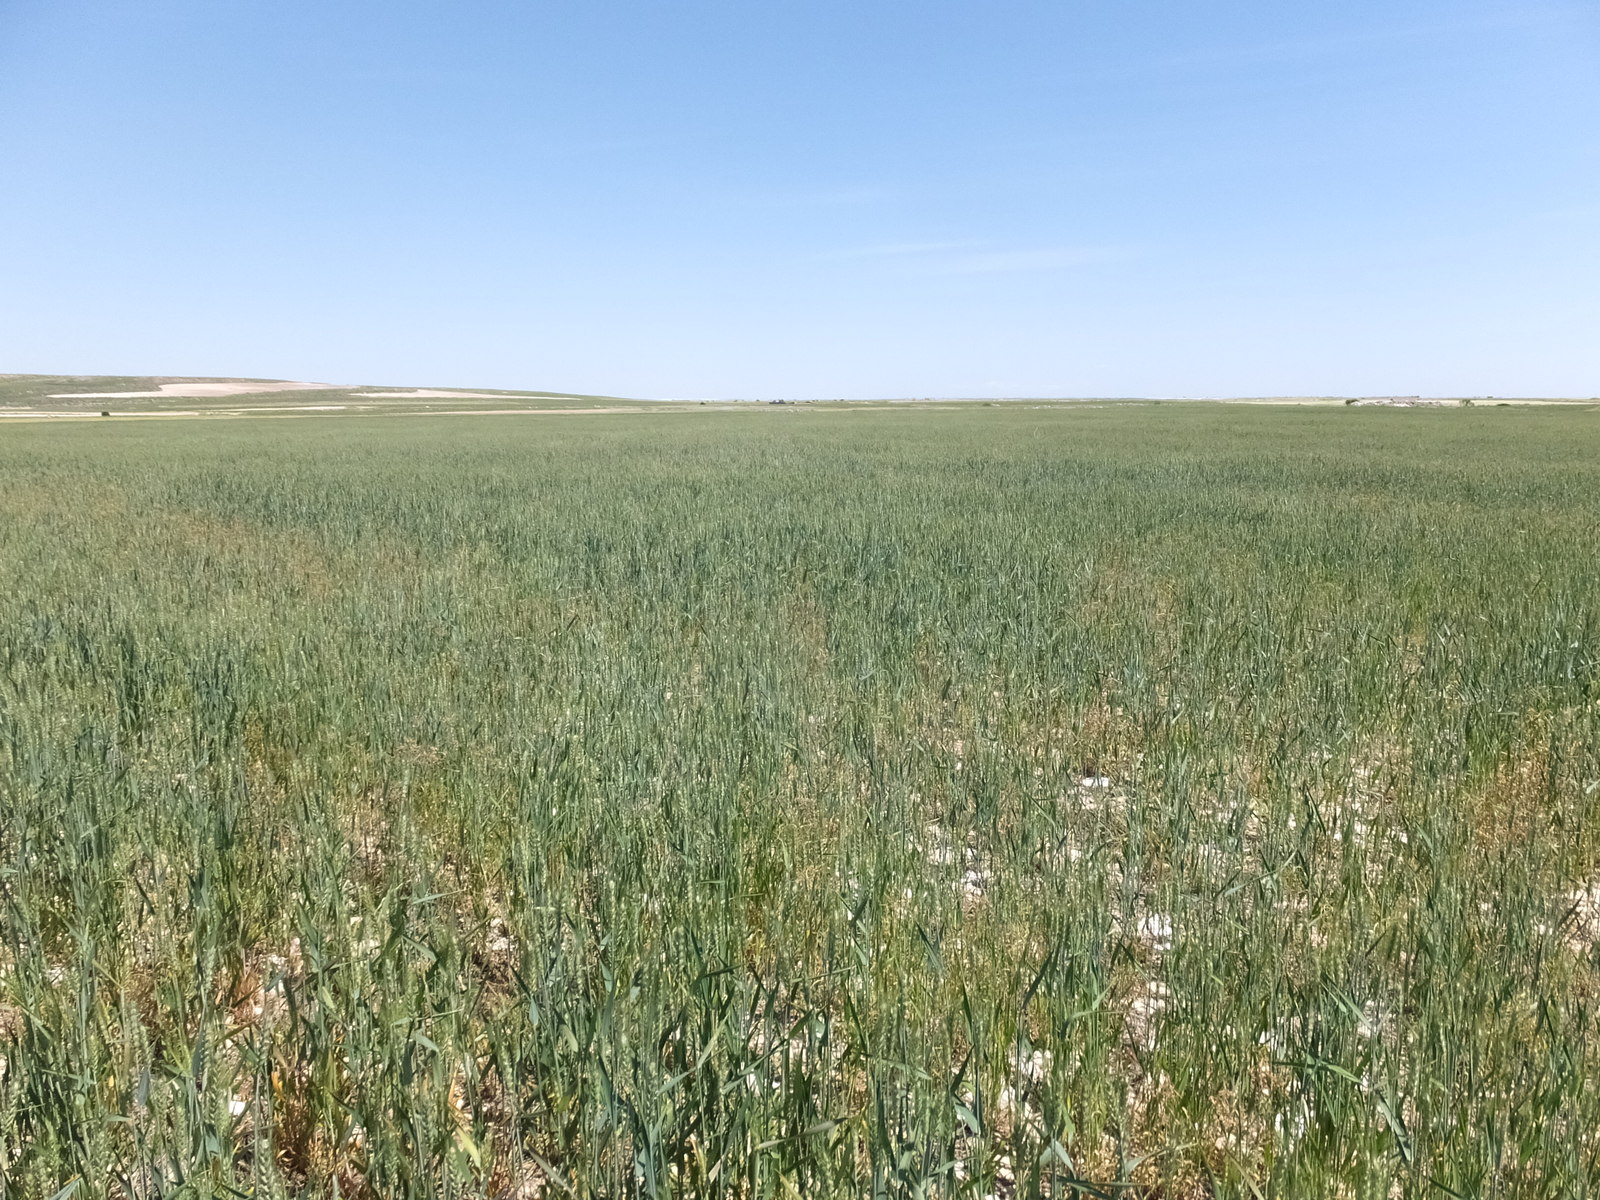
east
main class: Cropland
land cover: Durum wheat
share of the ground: > 75 %
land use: Agriculture (excluding fallow land and kitchen gardens)
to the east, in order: Durum wheat
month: May
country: ES
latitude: 41.3957
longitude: -0.3374
